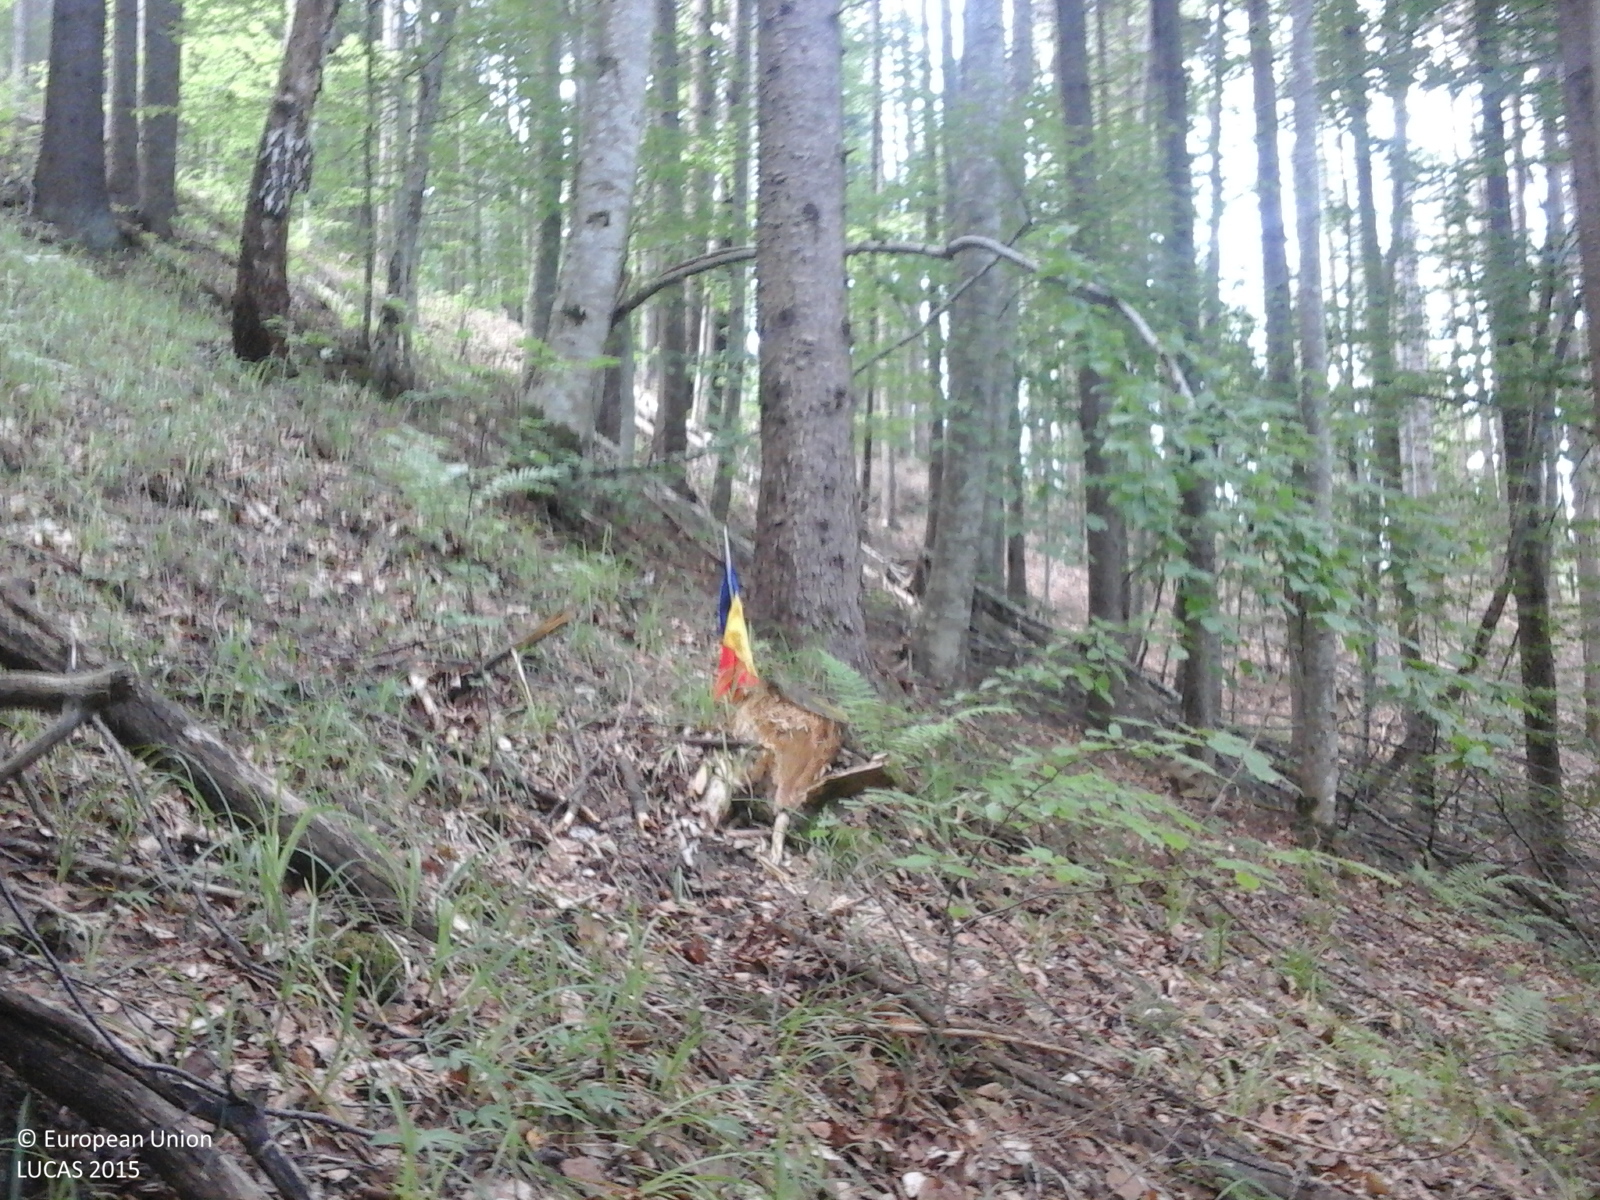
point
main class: Woodland
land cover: Broadleaved woodland
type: beech forest
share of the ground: > 75 %
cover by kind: broadleaved forest trees 100 %
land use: Forestry
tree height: > 5 m
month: June
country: RO
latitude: 46.7843
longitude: 26.1466
